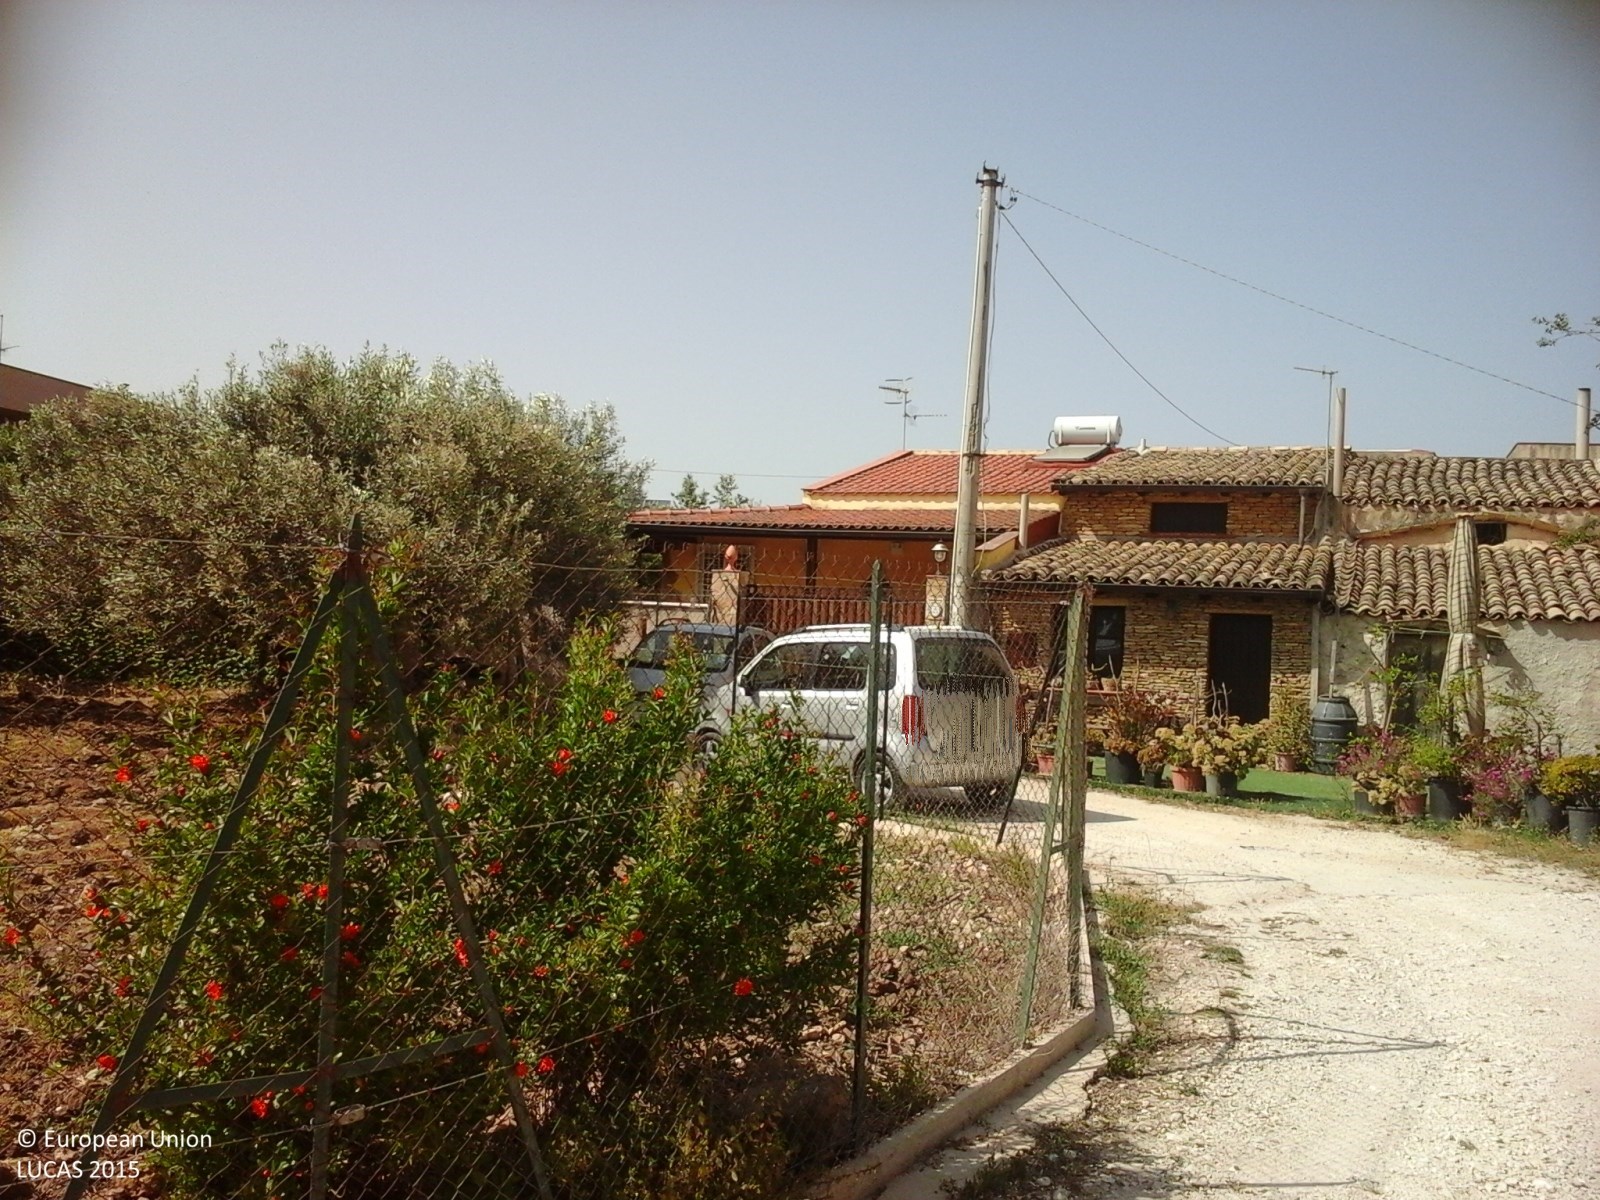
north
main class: Cropland
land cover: Olive groves
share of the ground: 25 - 50 %
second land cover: Other bare soil
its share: > 75 %
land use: Agriculture (excluding fallow land and kitchen gardens)
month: May
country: IT
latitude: 37.5346
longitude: 13.0660
